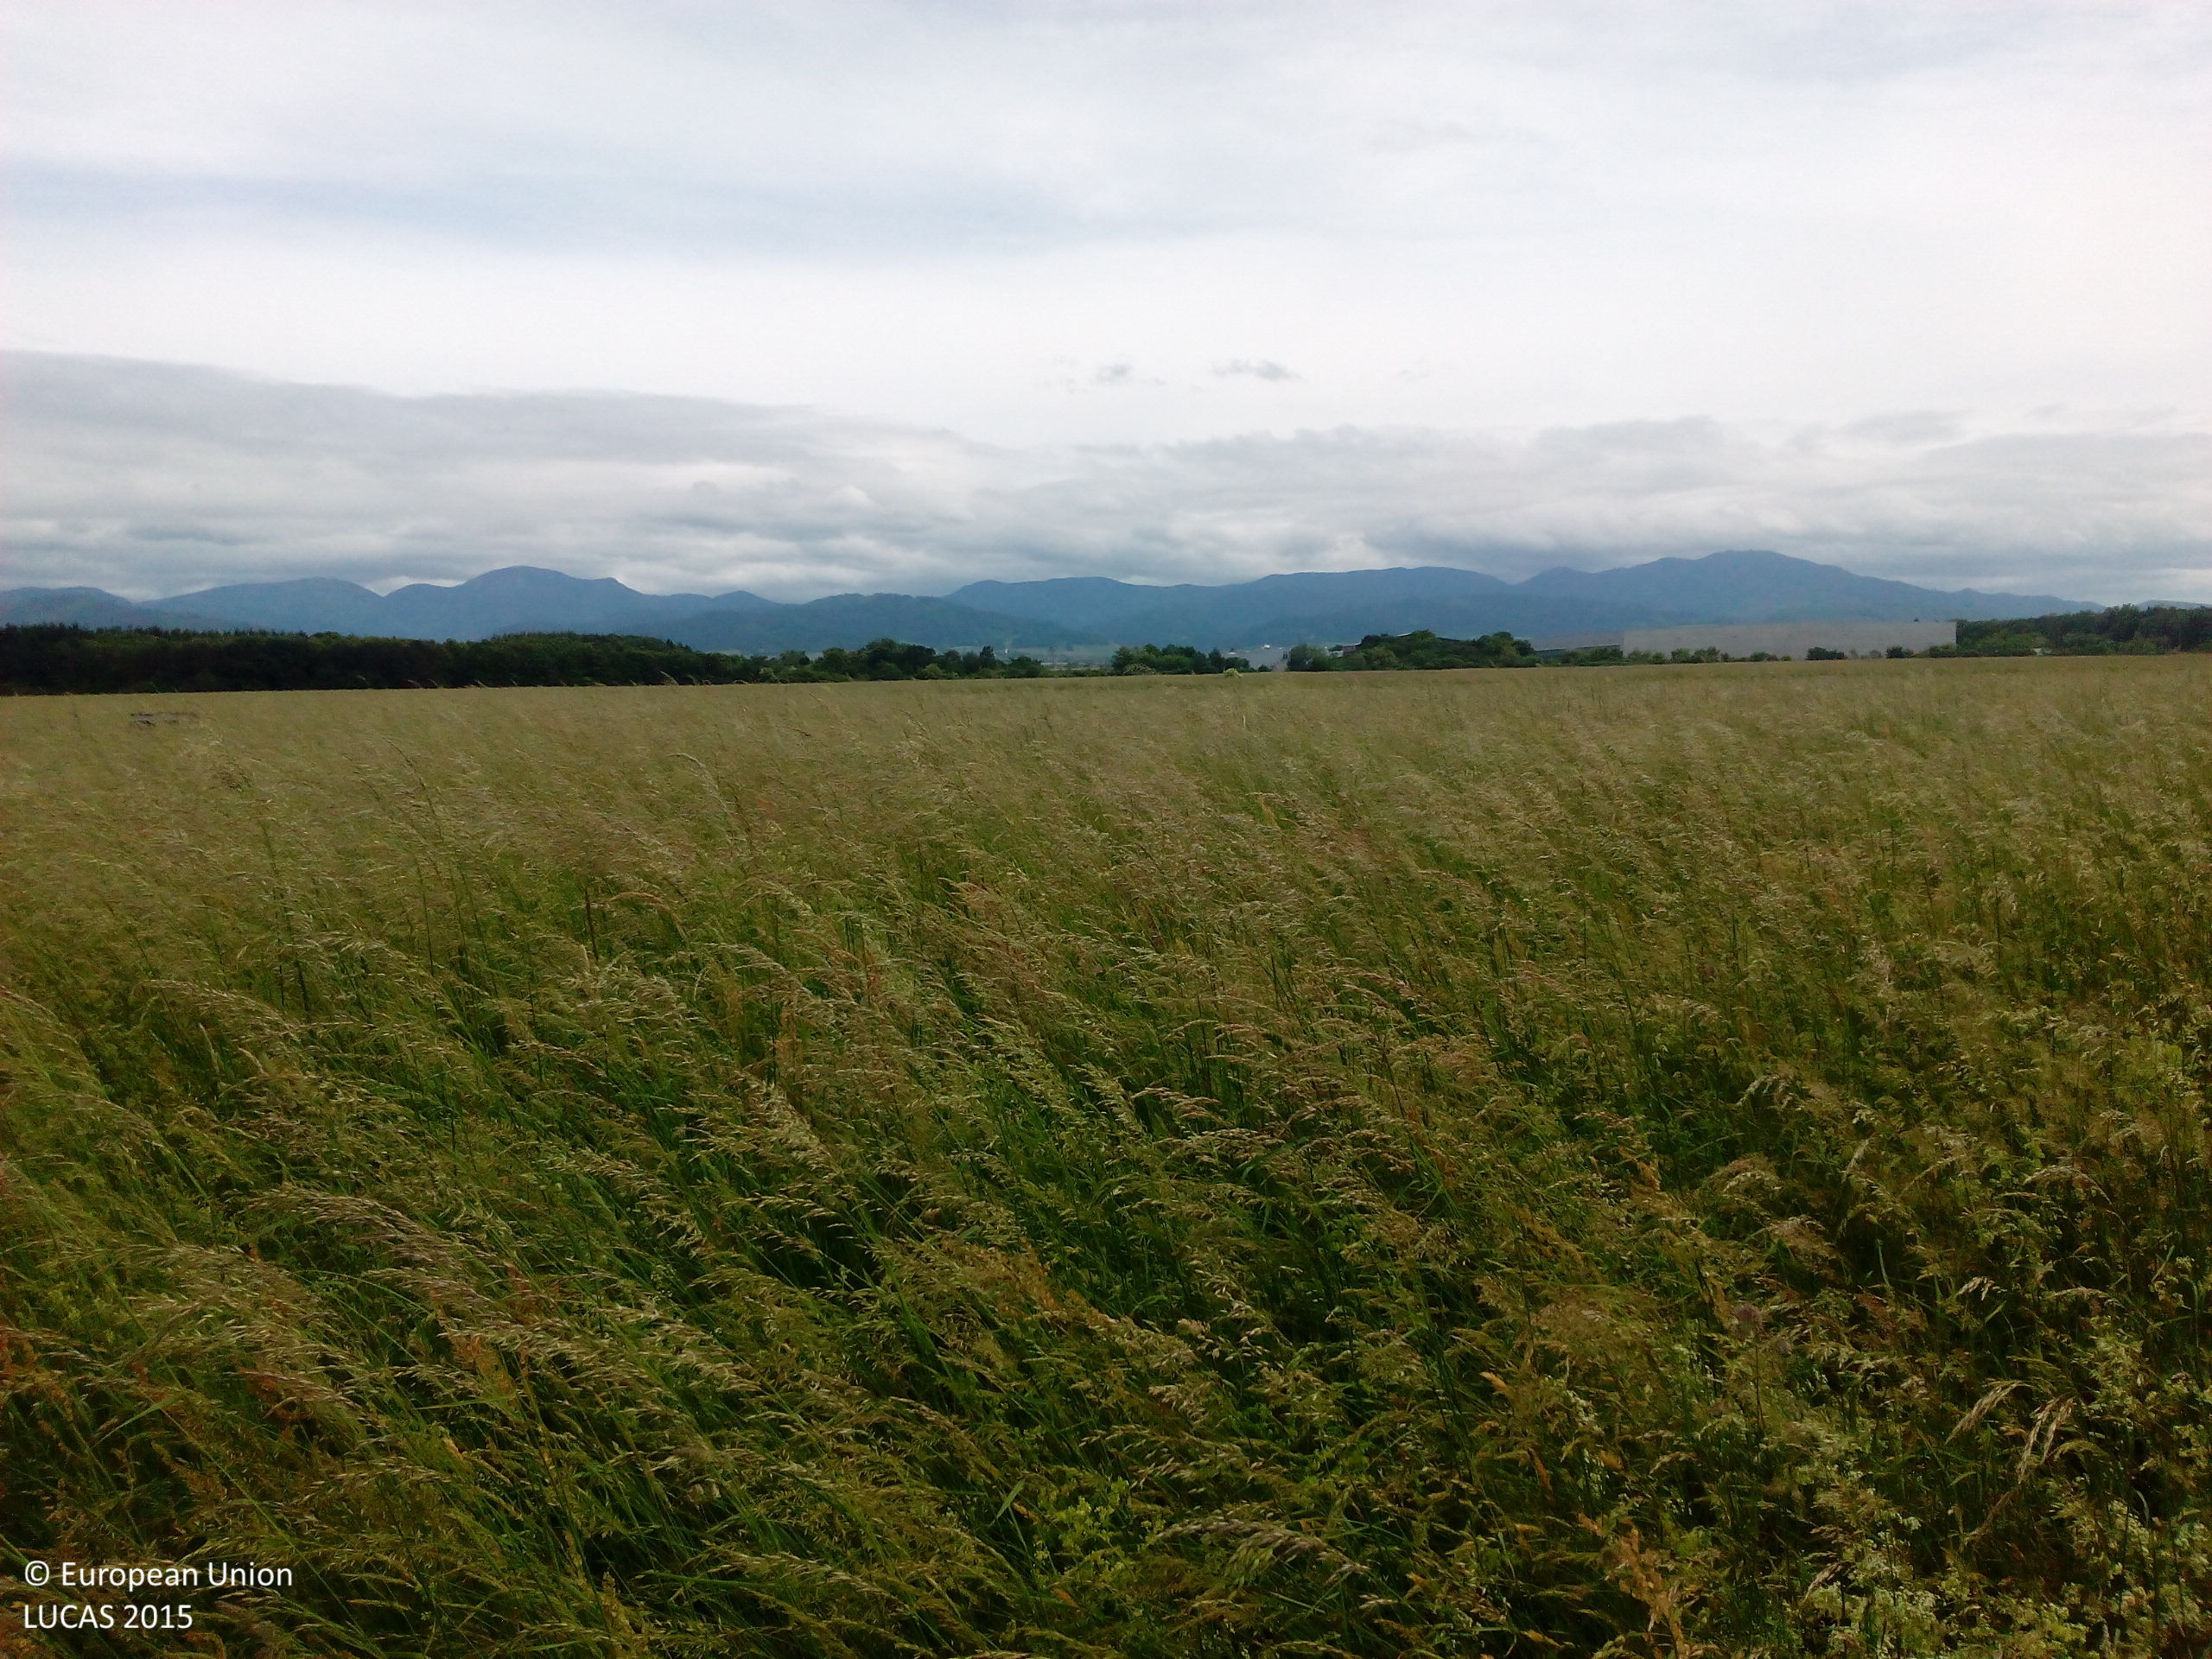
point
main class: Grassland
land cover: Grassland without tree/shrub cover
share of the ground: > 75 %
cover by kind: herbaceous plants 100 %
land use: Air transport
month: May
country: DE
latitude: 47.9101
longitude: 7.6331
